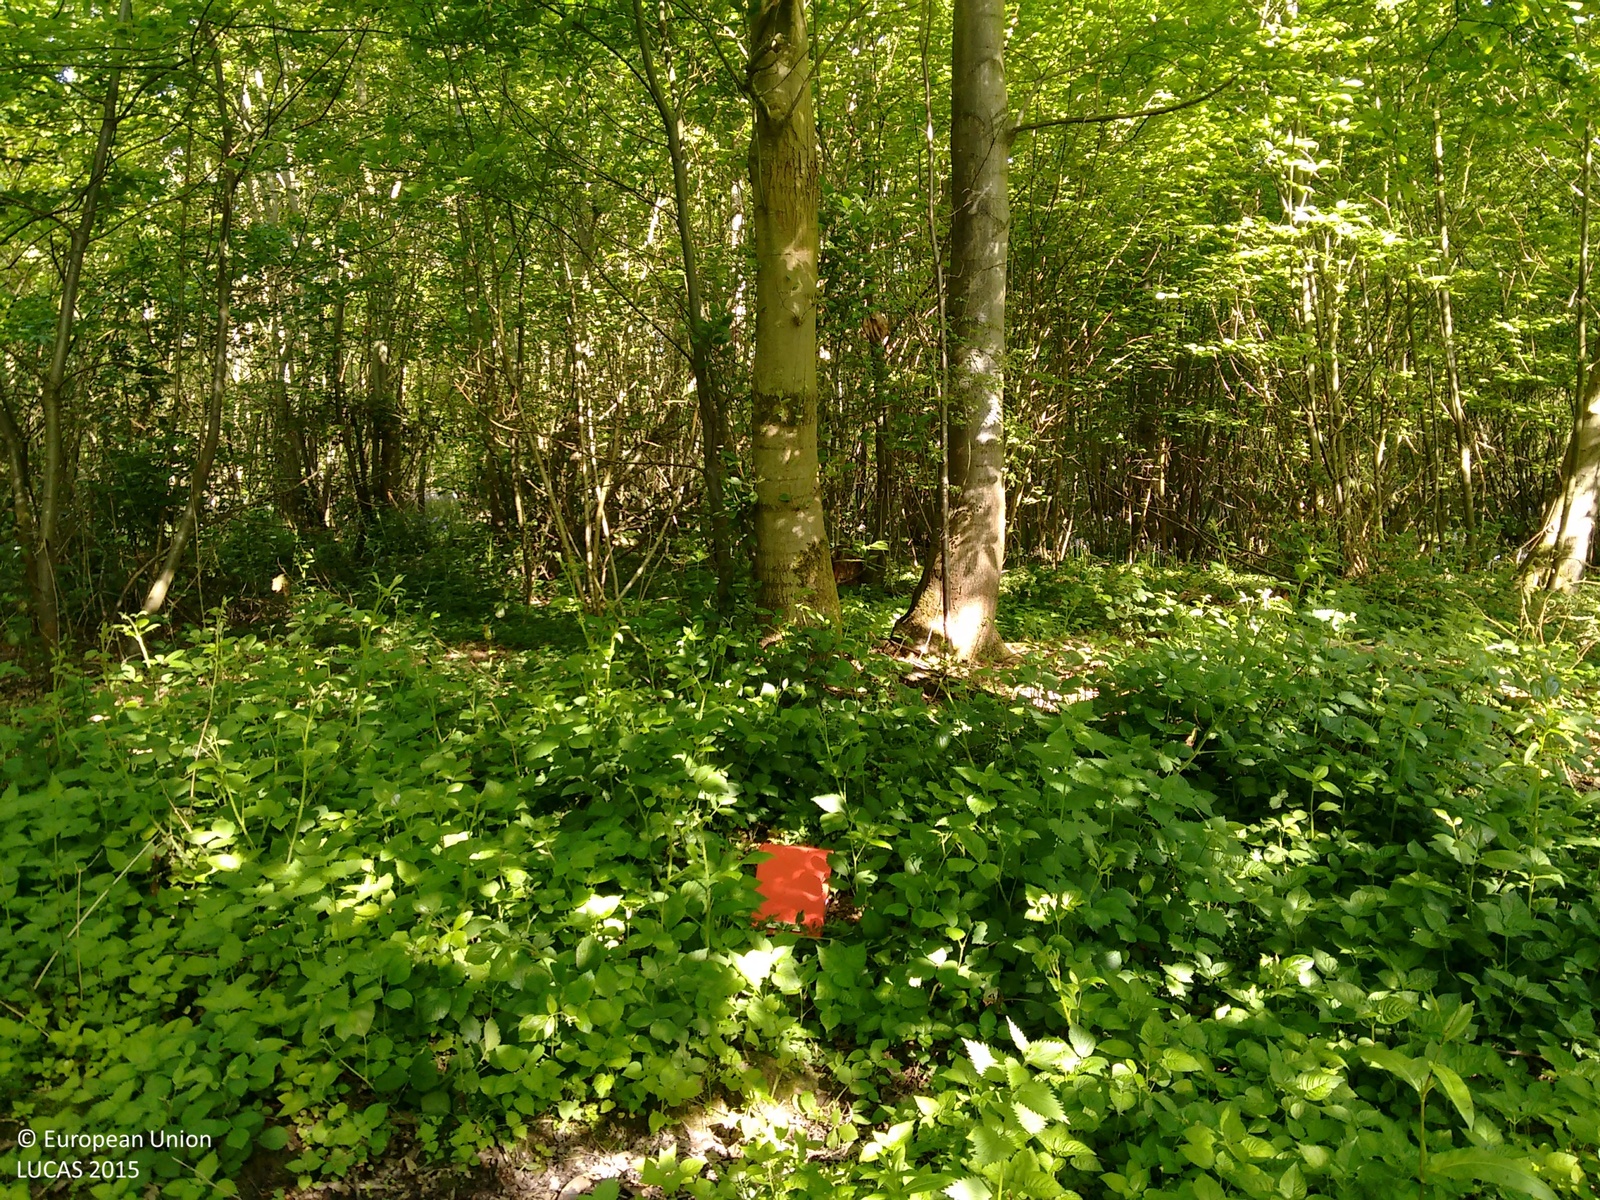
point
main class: Woodland
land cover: Broadleaved woodland
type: exotic forest
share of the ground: > 75 %
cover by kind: broadleaved forest trees 50 %, shrubs 40 %, herbaceous plants 10 %
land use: Forestry
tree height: > 5 m
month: May
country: GB
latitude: 51.2183
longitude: 1.2018
